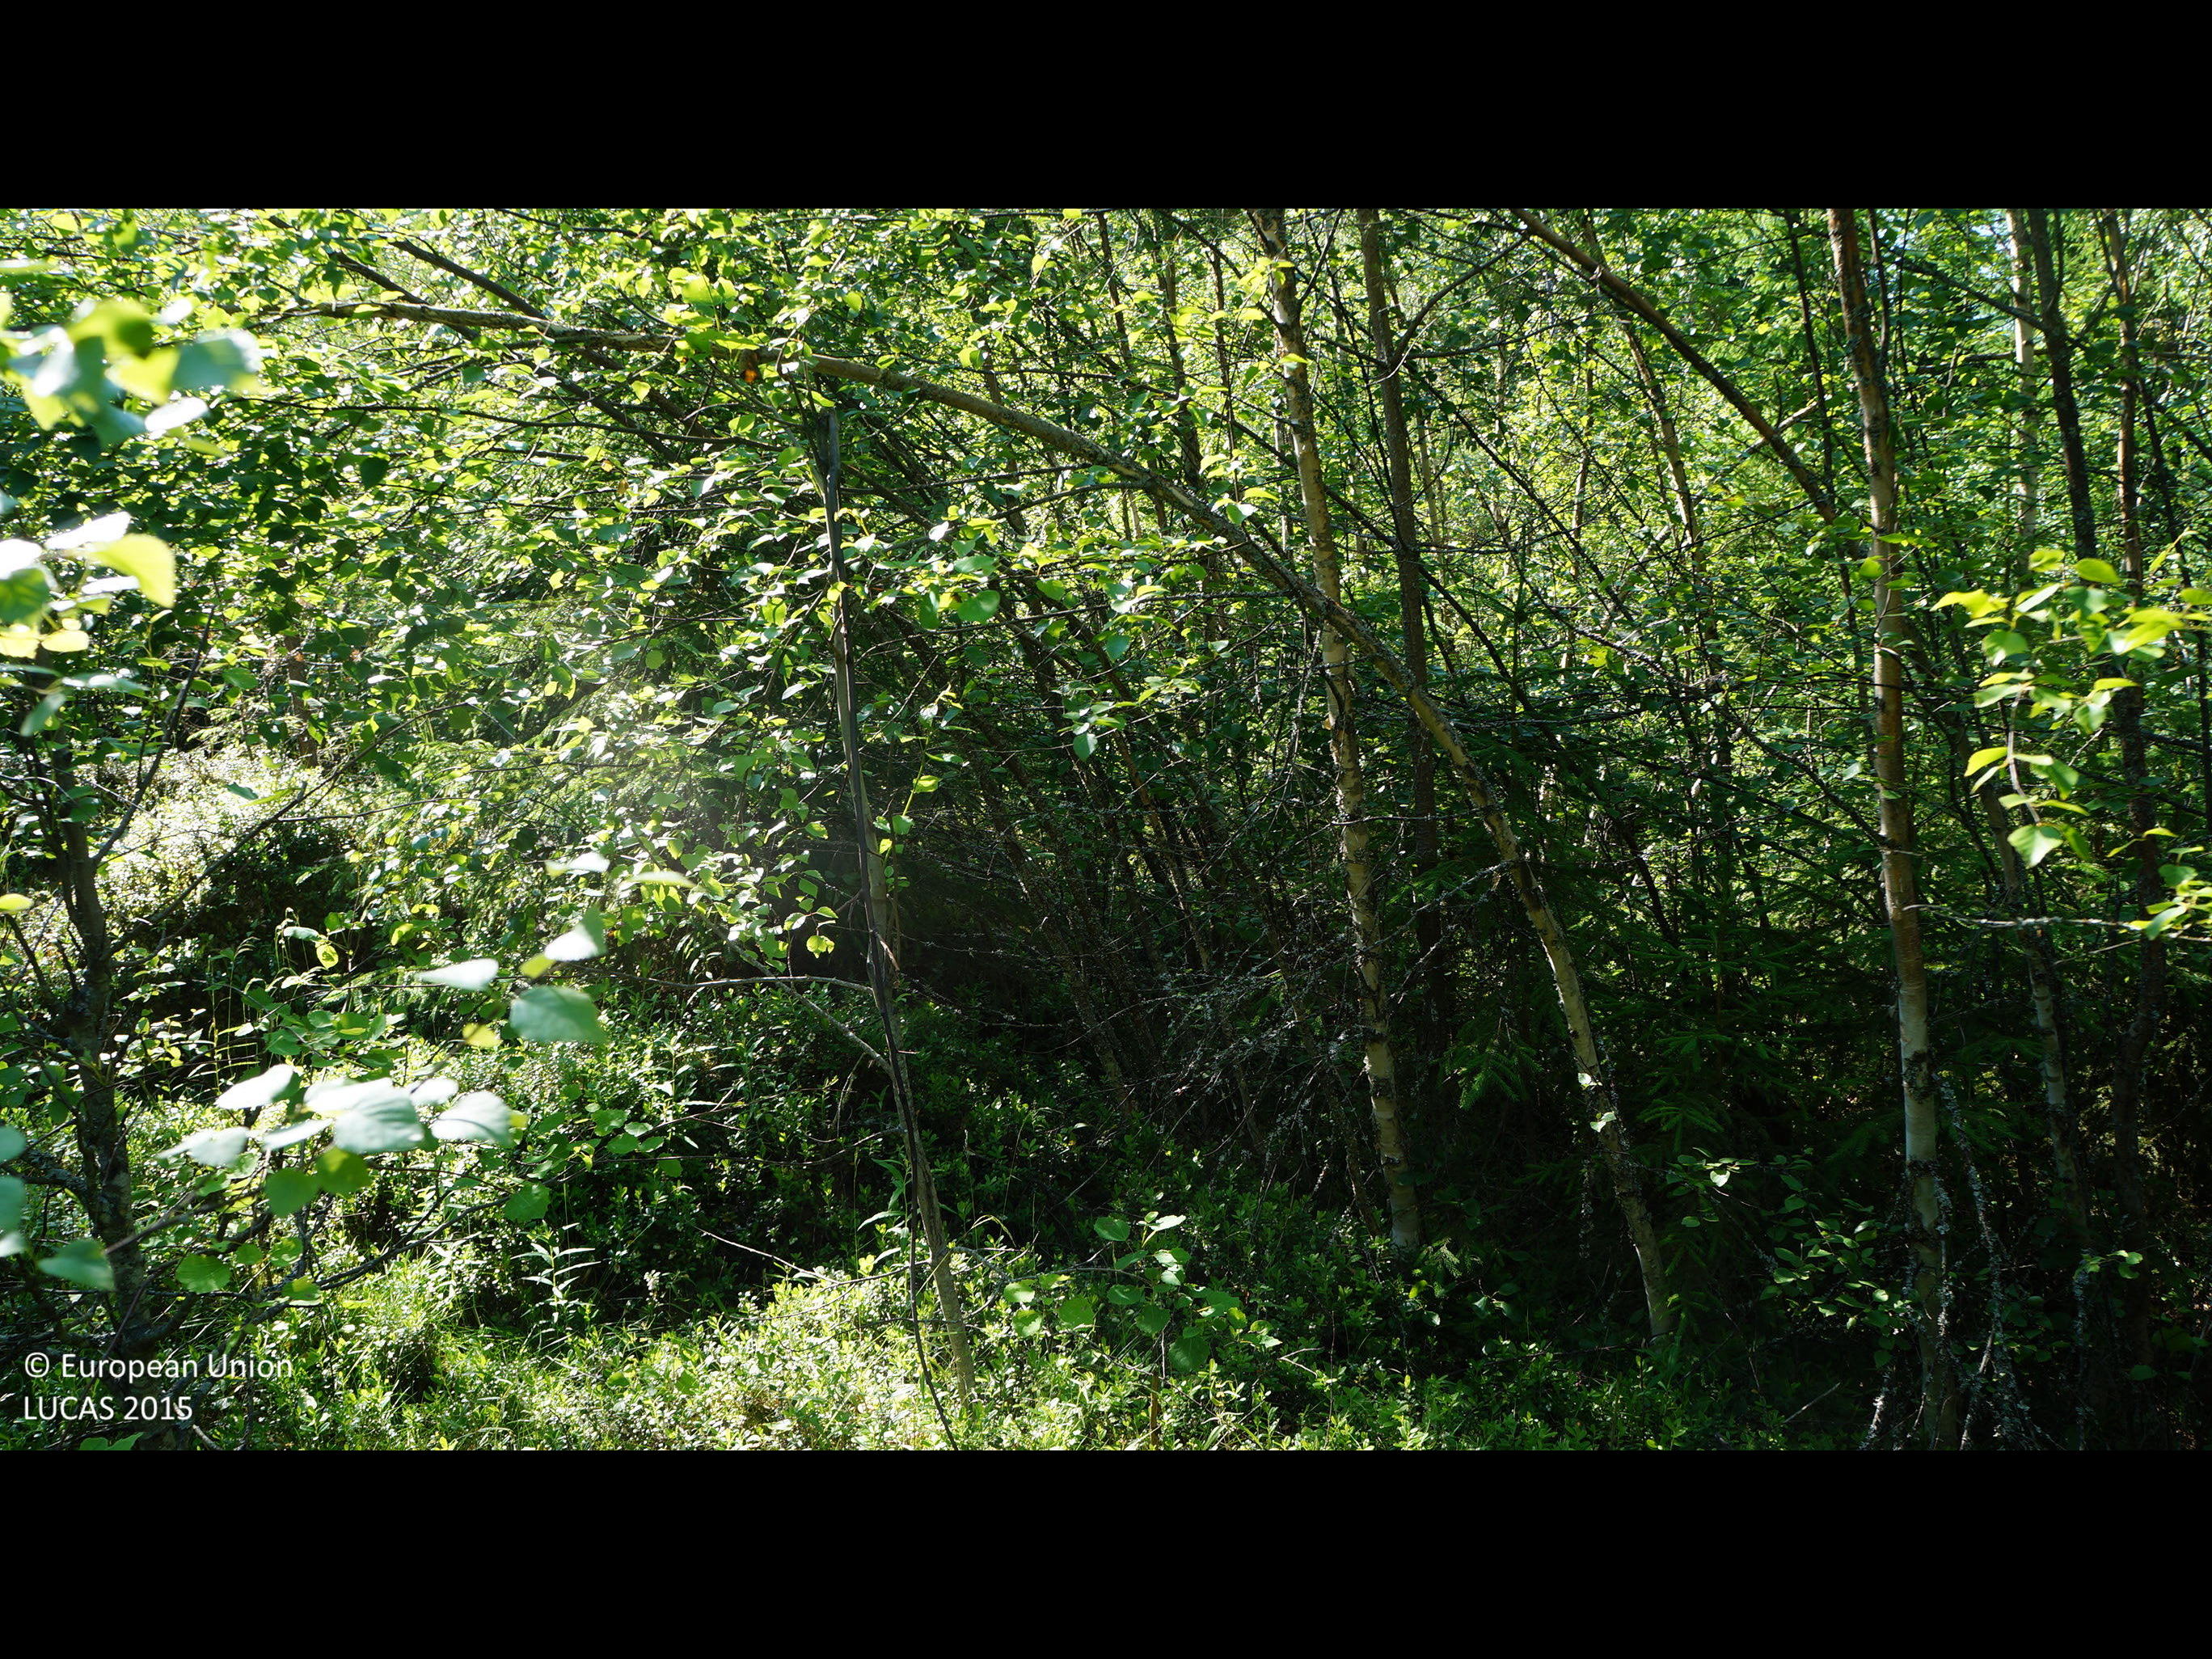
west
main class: Woodland
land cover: Broadleaved woodland
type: boreal forest
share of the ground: 50 - 75 %
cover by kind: broadleaved forest trees 50 %, shrubs 45 %, coniferous forest trees 5 %
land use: Forestry
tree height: > 5 m
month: July
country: FI
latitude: 63.6942
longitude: 23.0170
